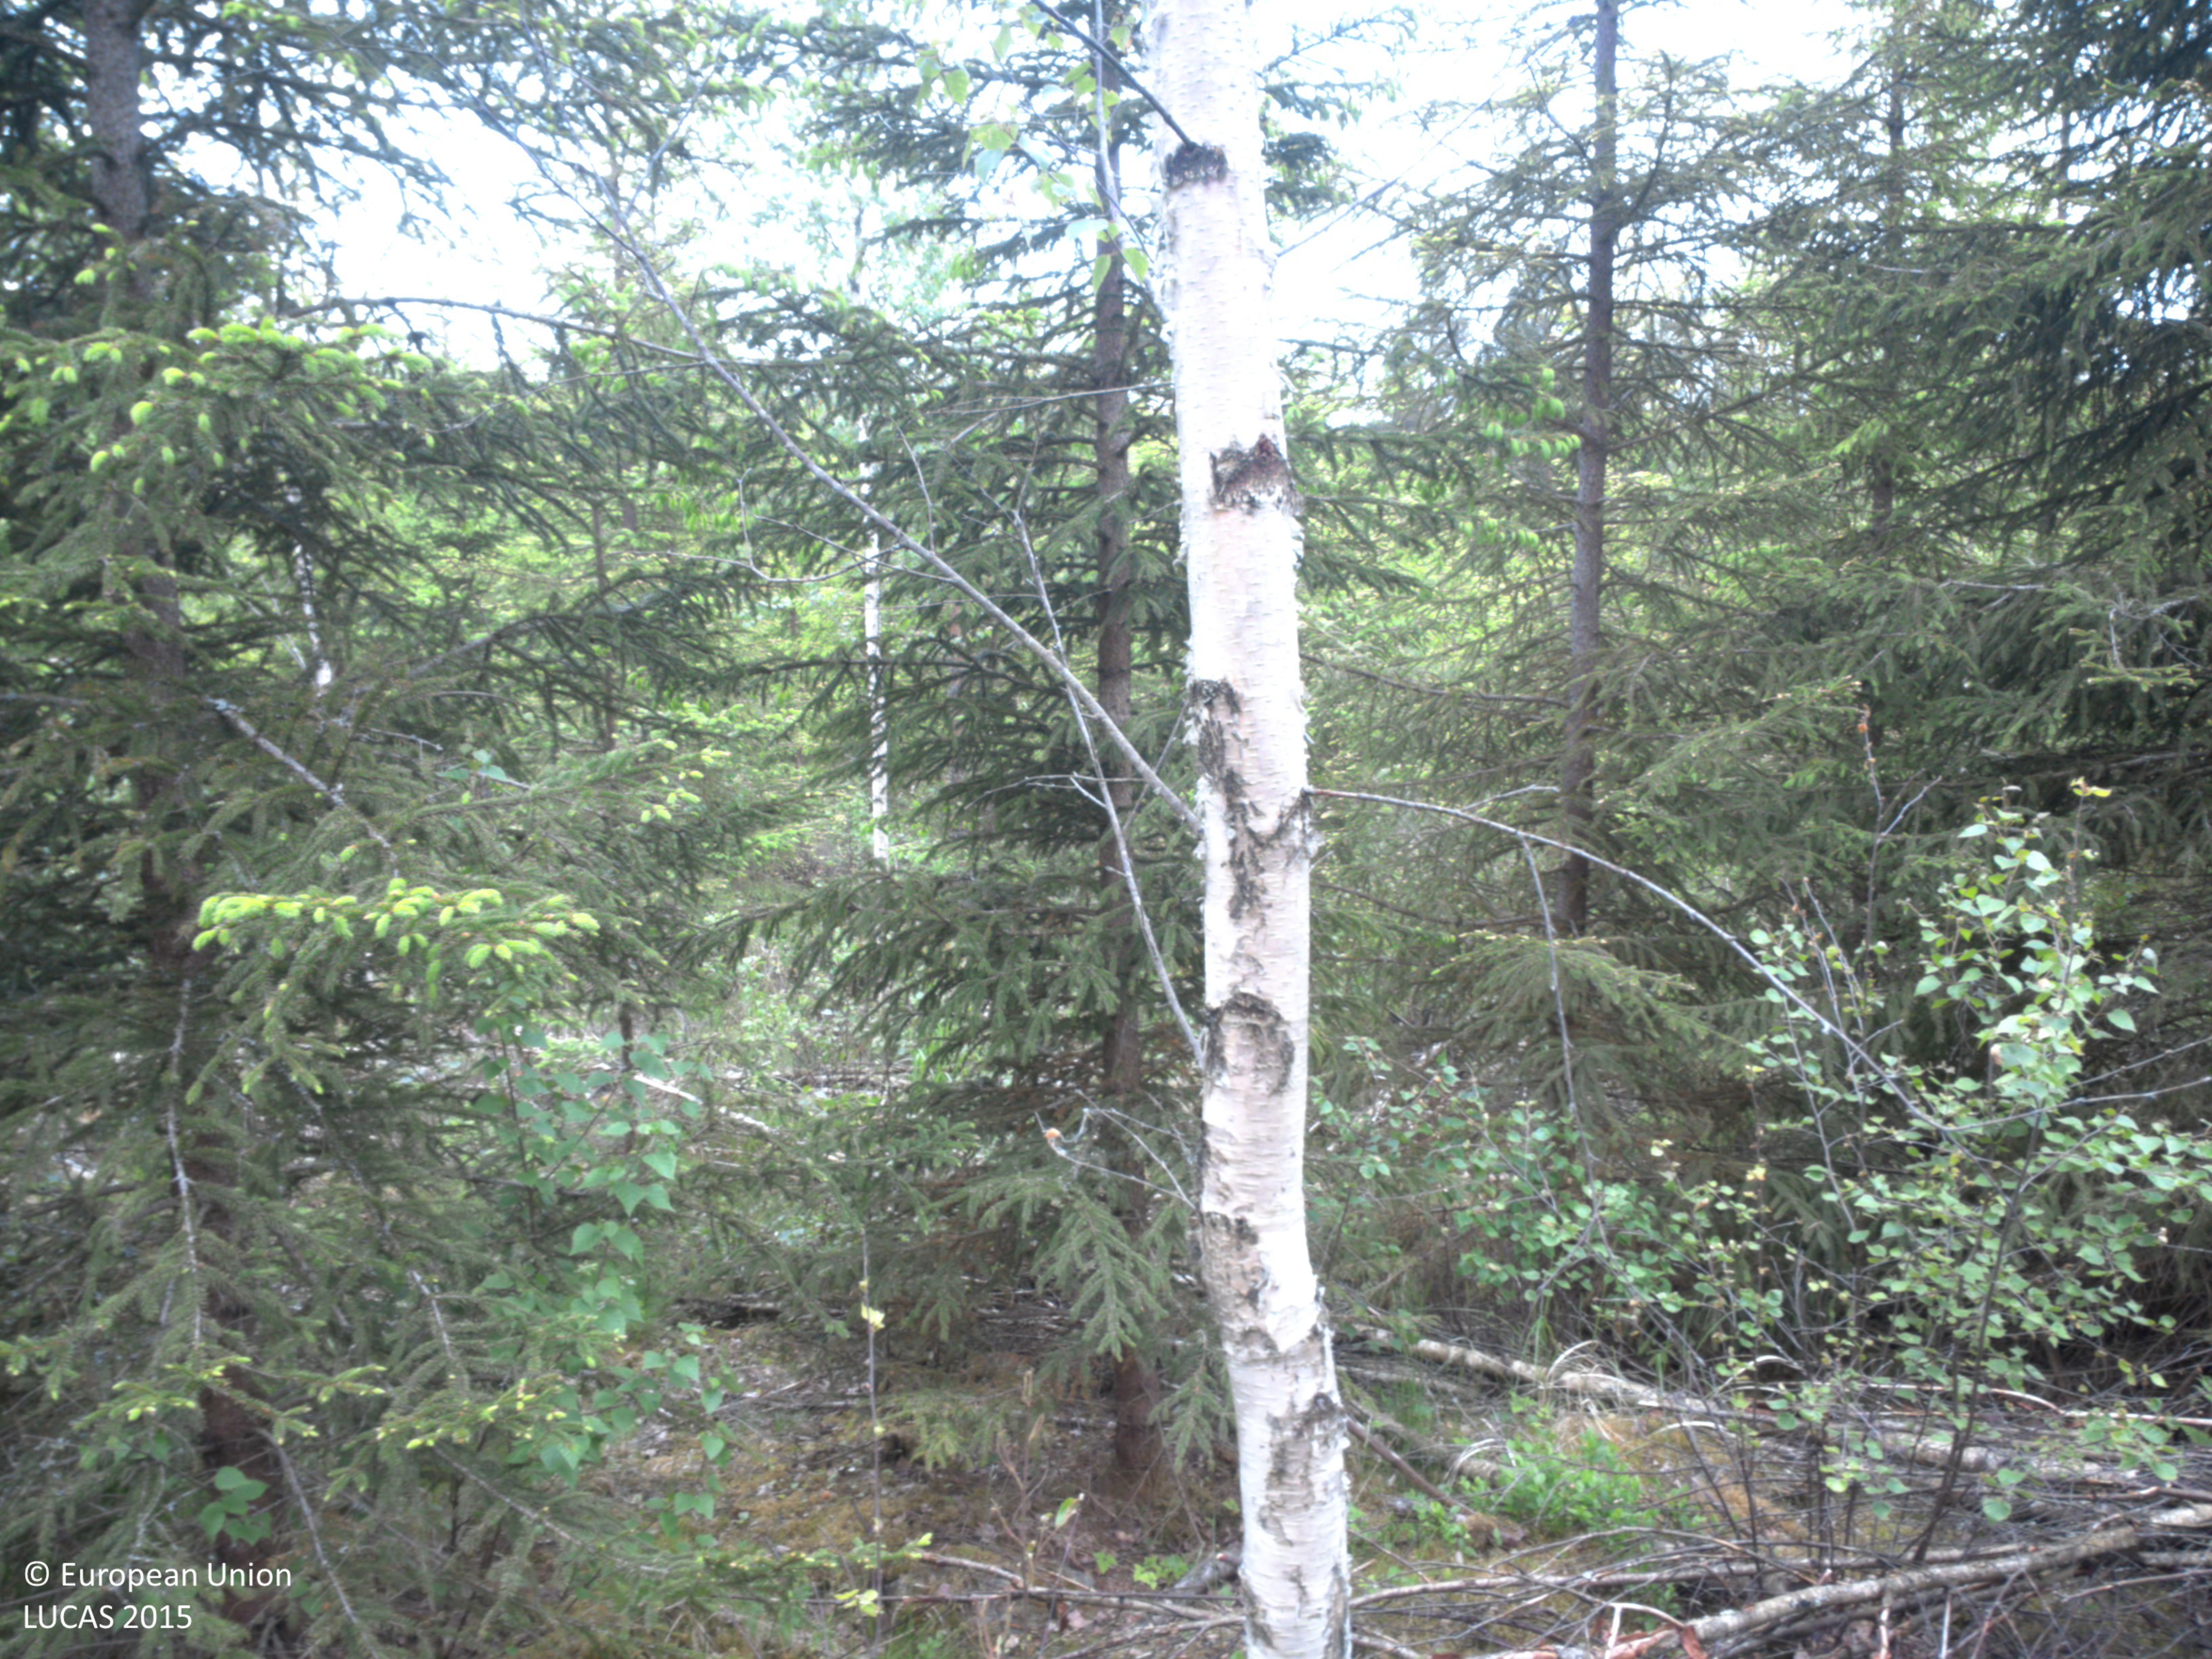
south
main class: Woodland
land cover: Spruce dominated mixed woodland
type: boreal forest
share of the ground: 50 - 75 %
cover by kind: coniferous forest trees 45 %, broadleaved forest trees 25 %, herbaceous plants 20 %, shrubs 10 %
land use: Forestry
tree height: > 5 m
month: June
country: SE
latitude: 59.1587
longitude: 11.9713
